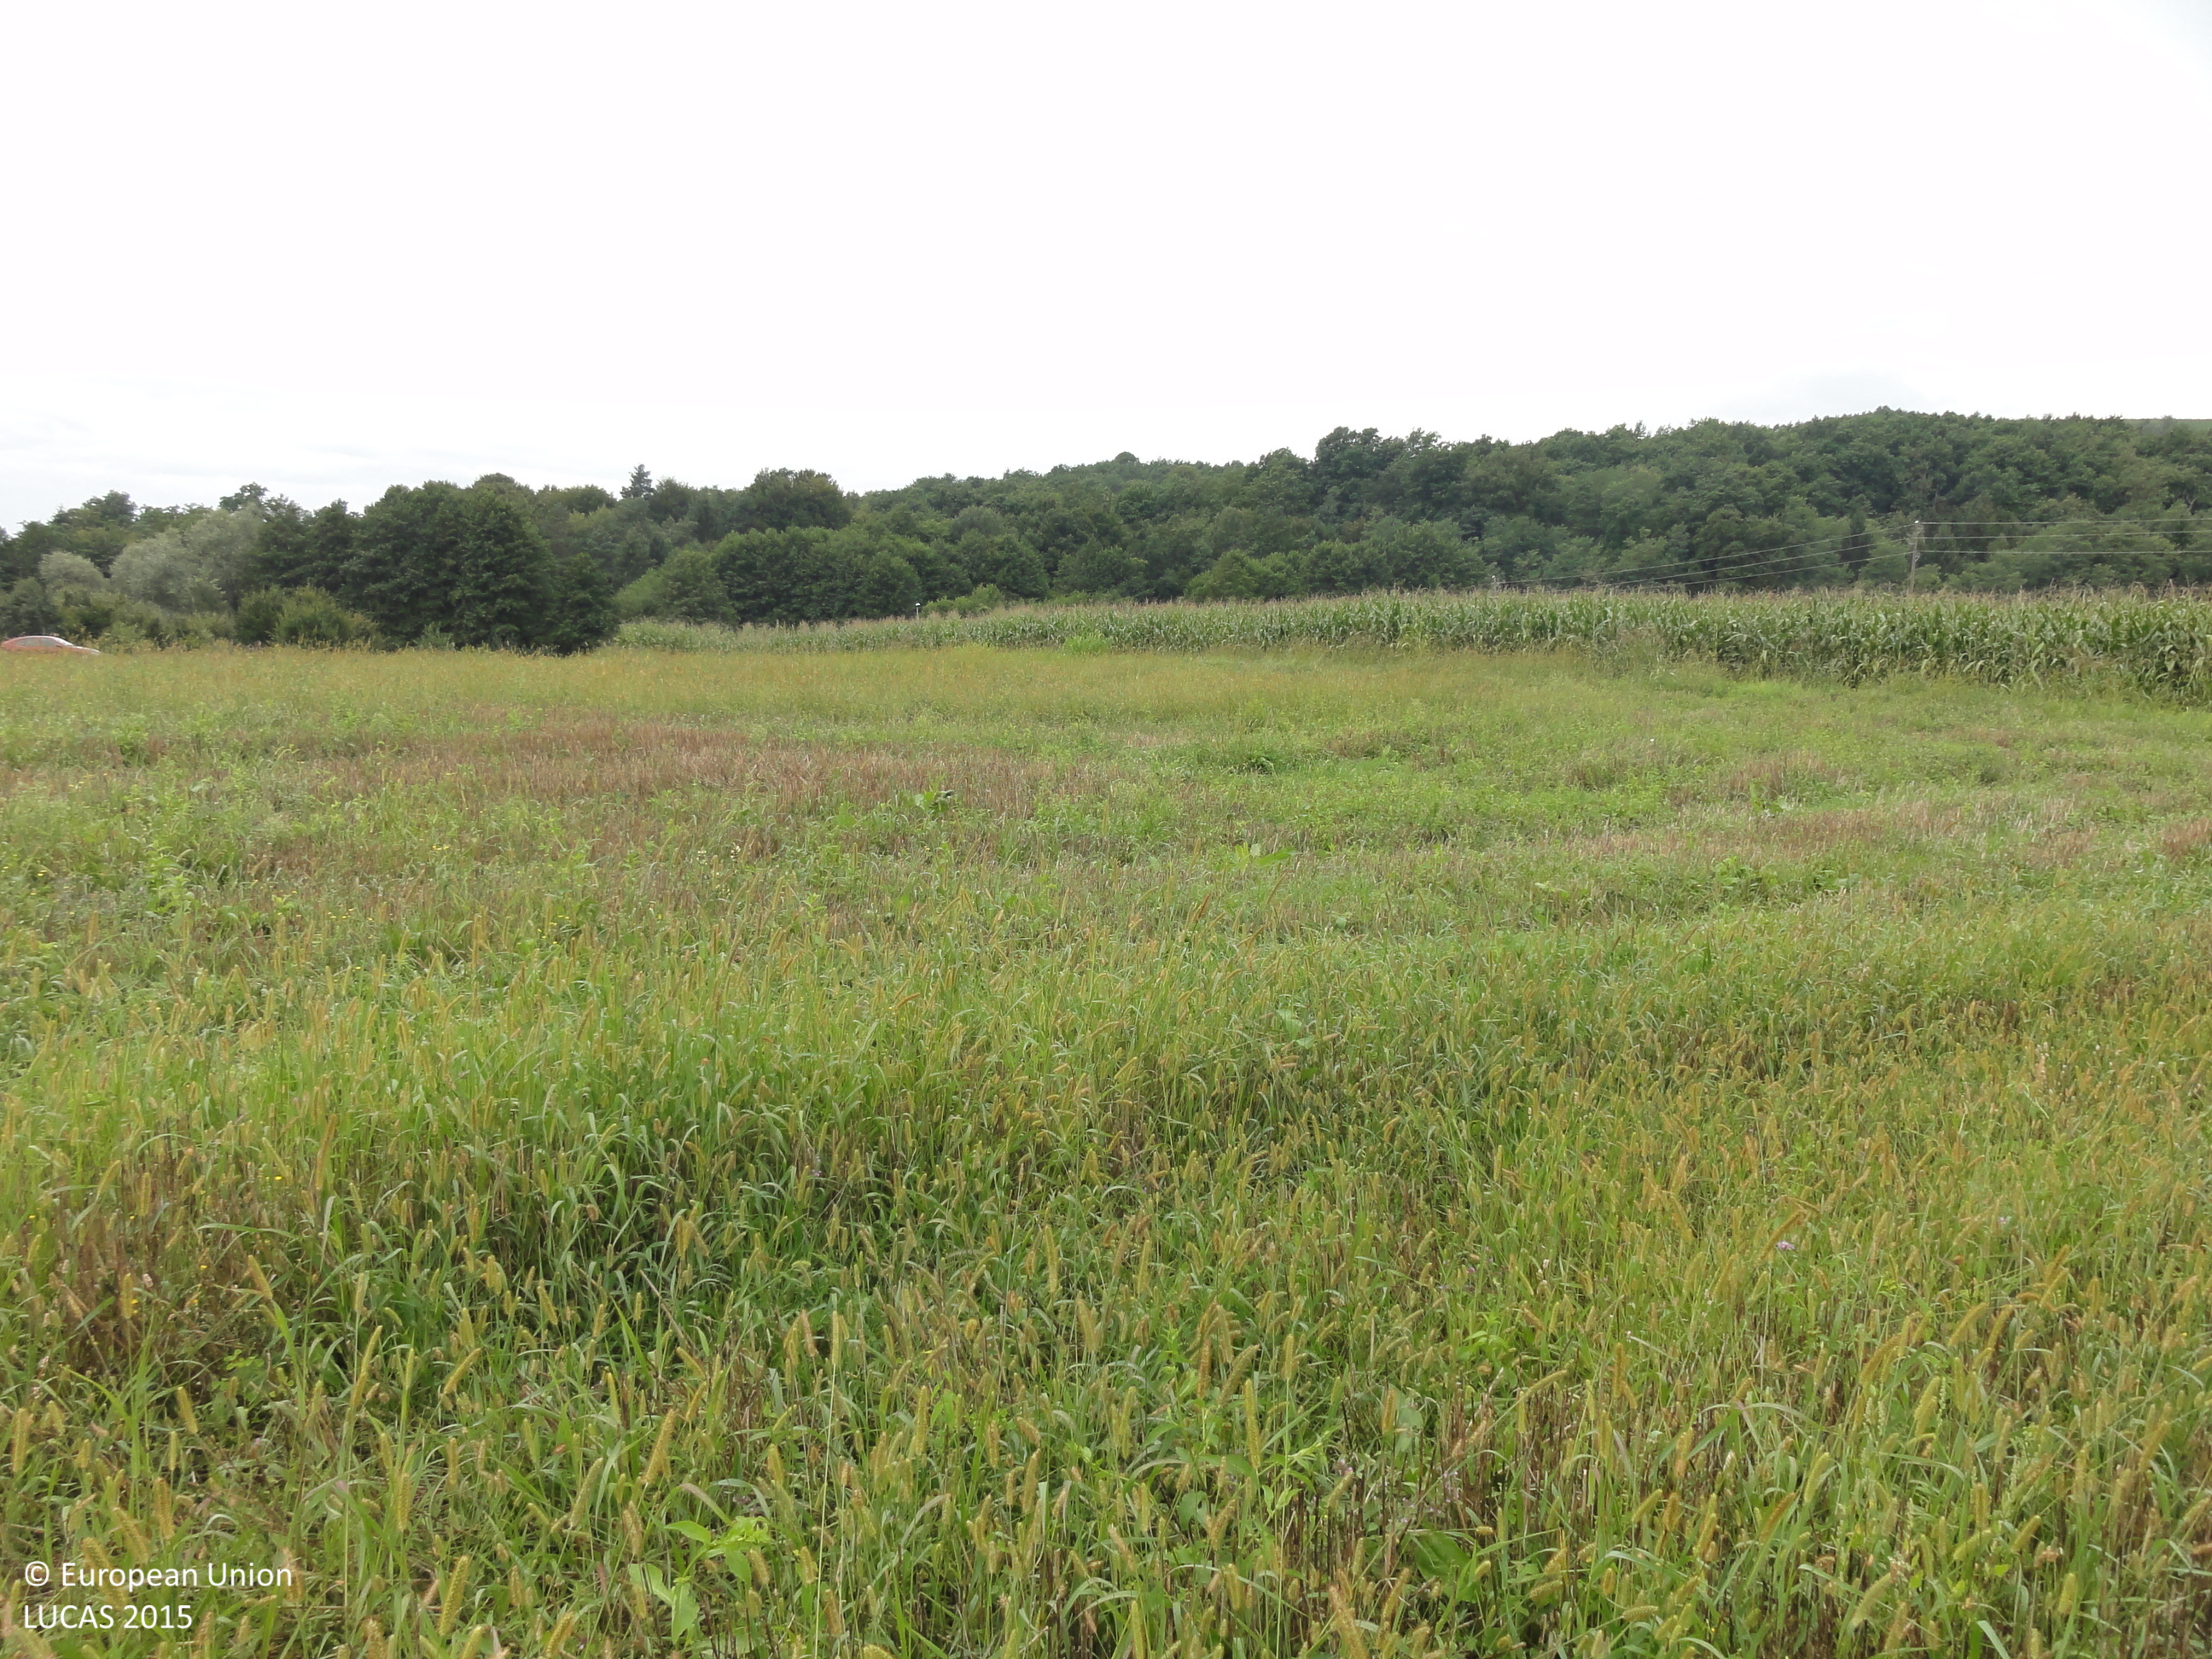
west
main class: Cropland
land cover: Common wheat
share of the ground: < 10 %
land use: Agriculture (excluding fallow land and kitchen gardens)
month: August
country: SI
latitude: 45.9413
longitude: 15.4535
